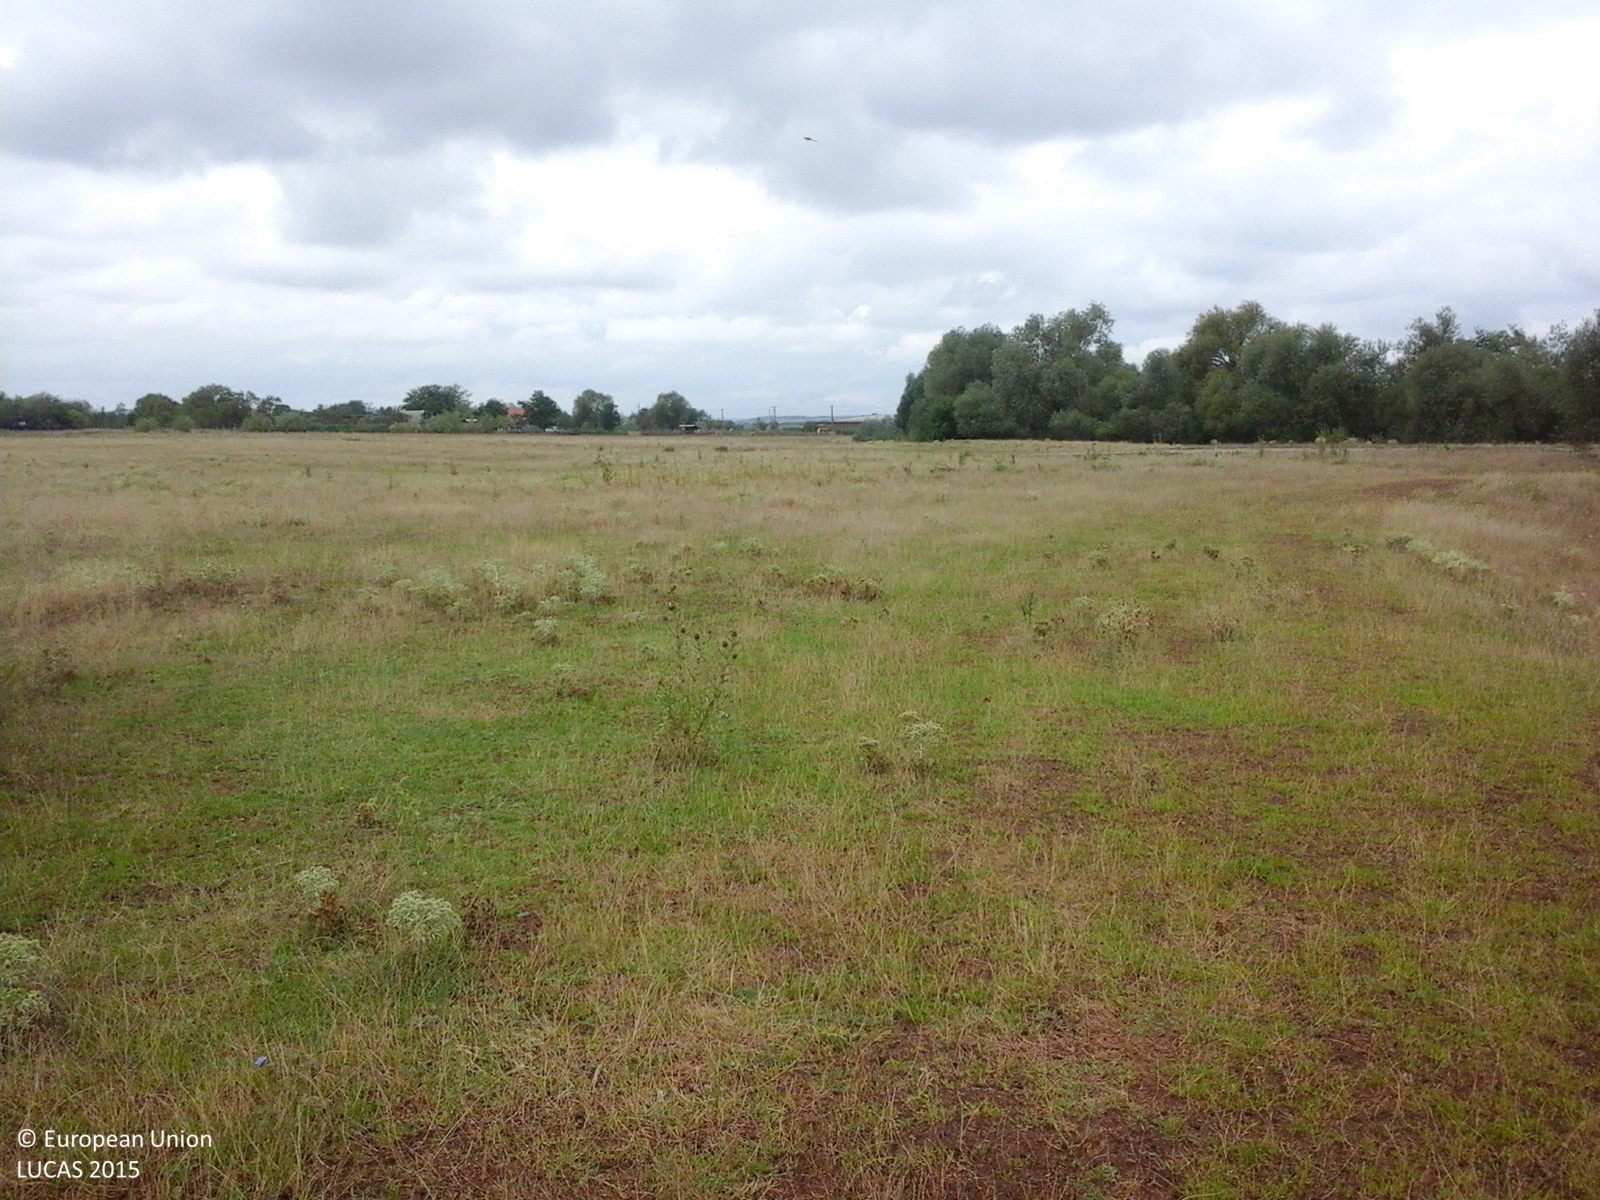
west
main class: Grassland
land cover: Grassland without tree/shrub cover
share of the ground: > 75 %
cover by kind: herbaceous plants 100 %
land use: Agriculture (excluding fallow land and kitchen gardens)
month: August
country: RO
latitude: 45.8063
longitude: 21.7857
